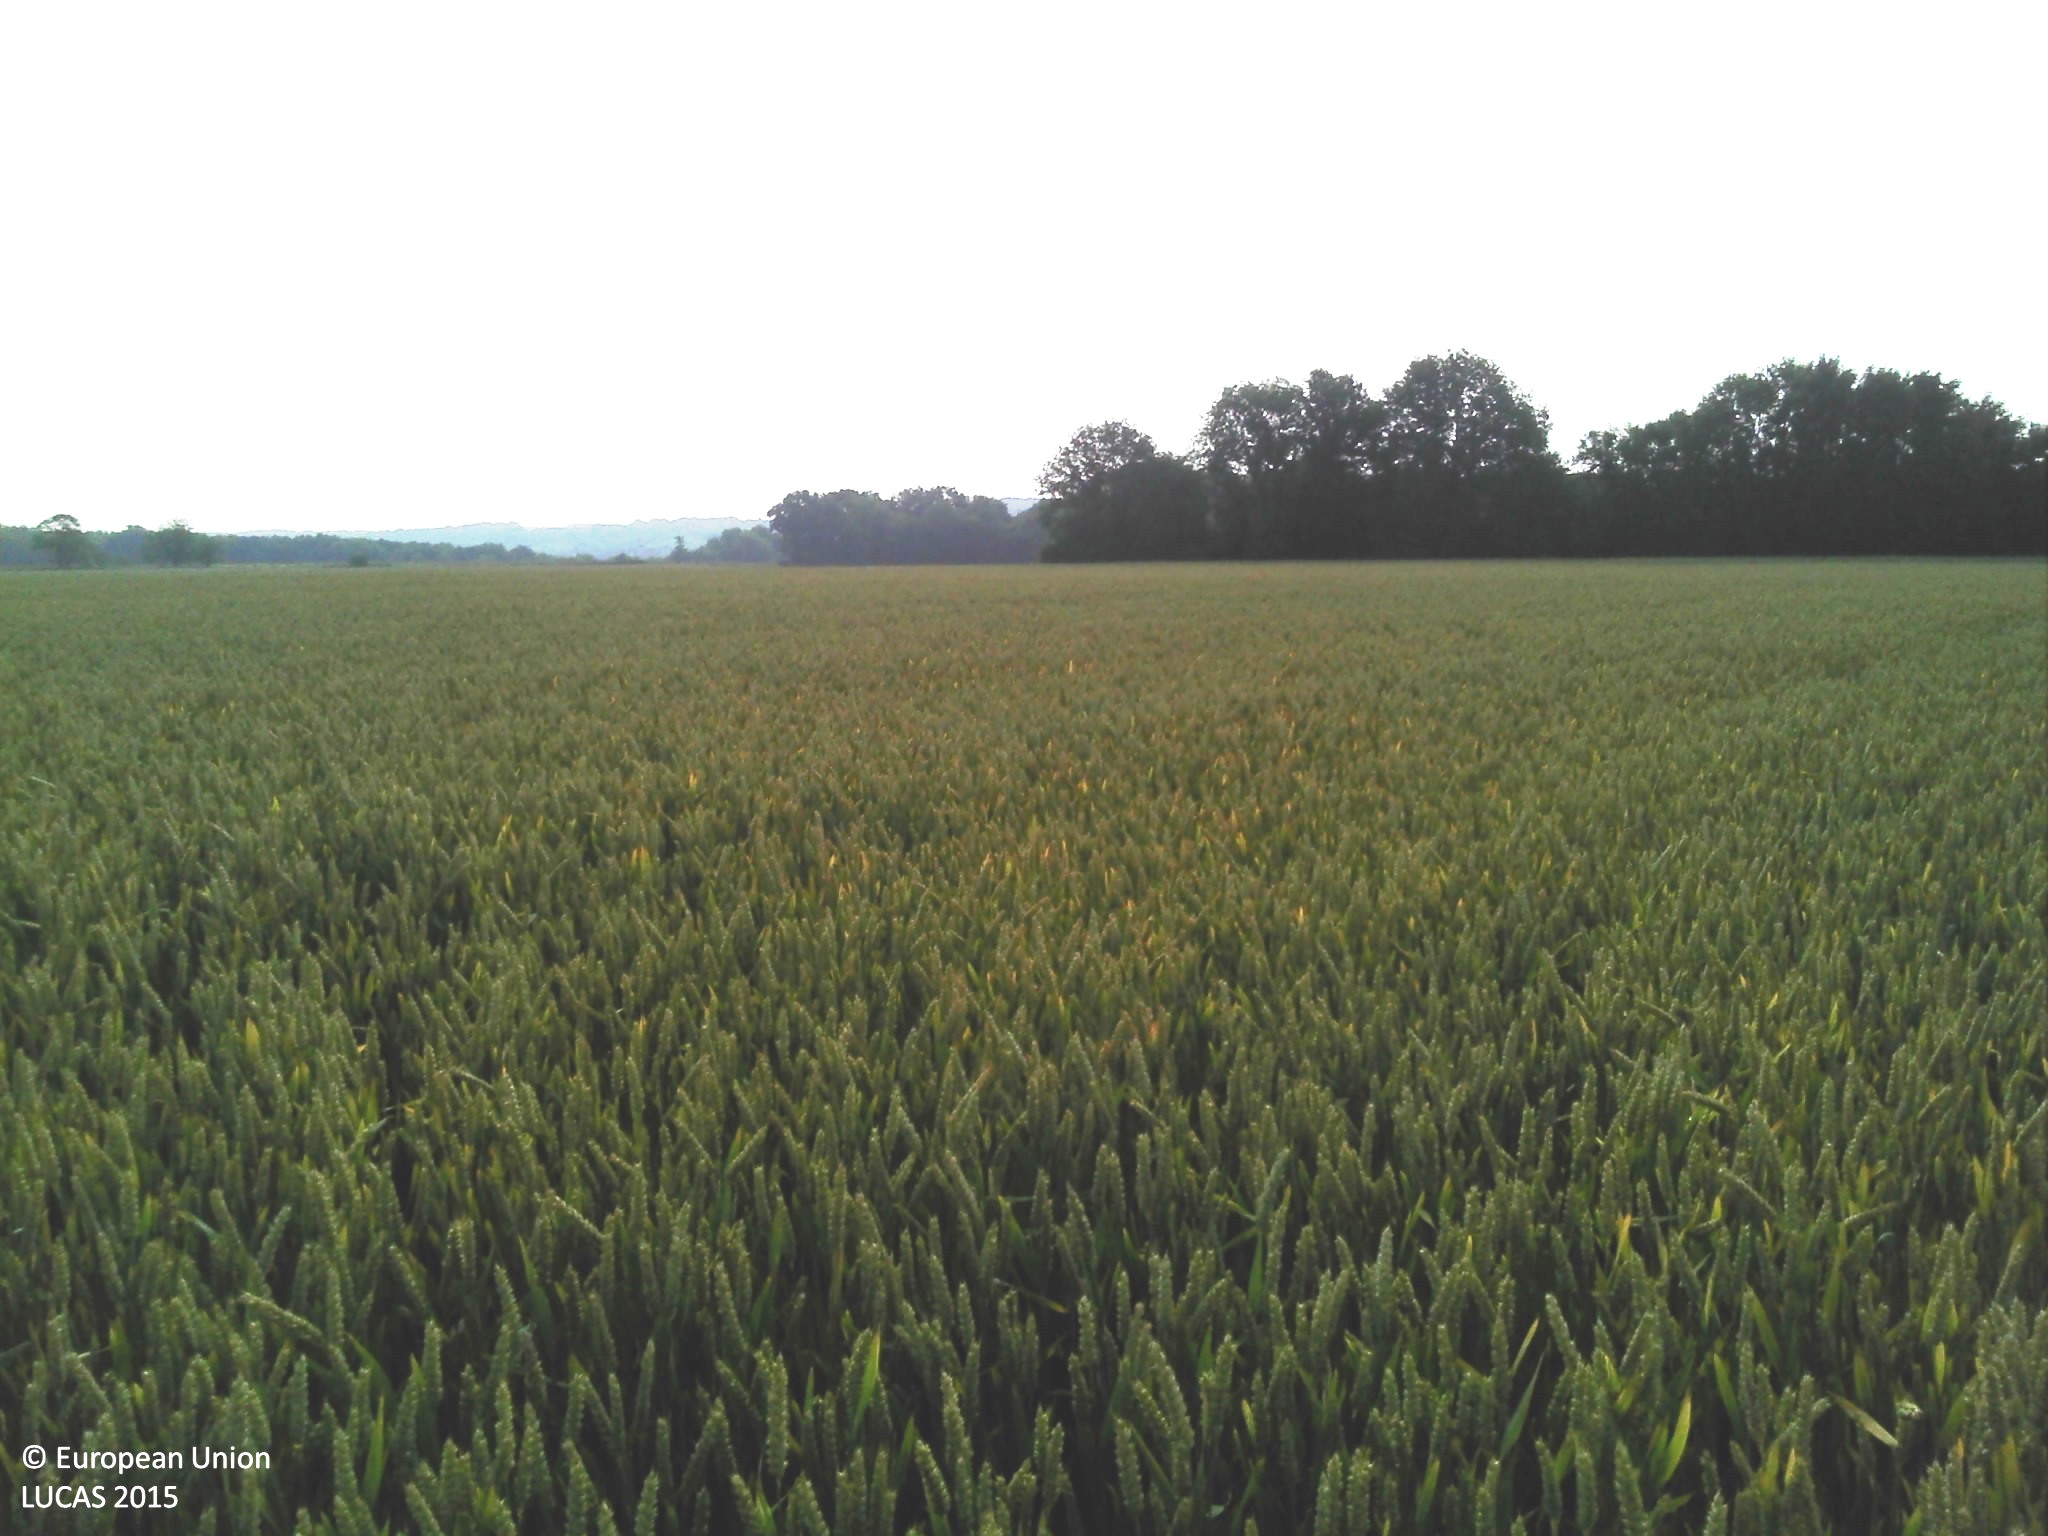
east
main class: Cropland
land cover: Common wheat
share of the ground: > 75 %
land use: Agriculture (excluding fallow land and kitchen gardens)
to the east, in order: Common wheat
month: June
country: FR
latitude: 46.5377
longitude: 0.8446
